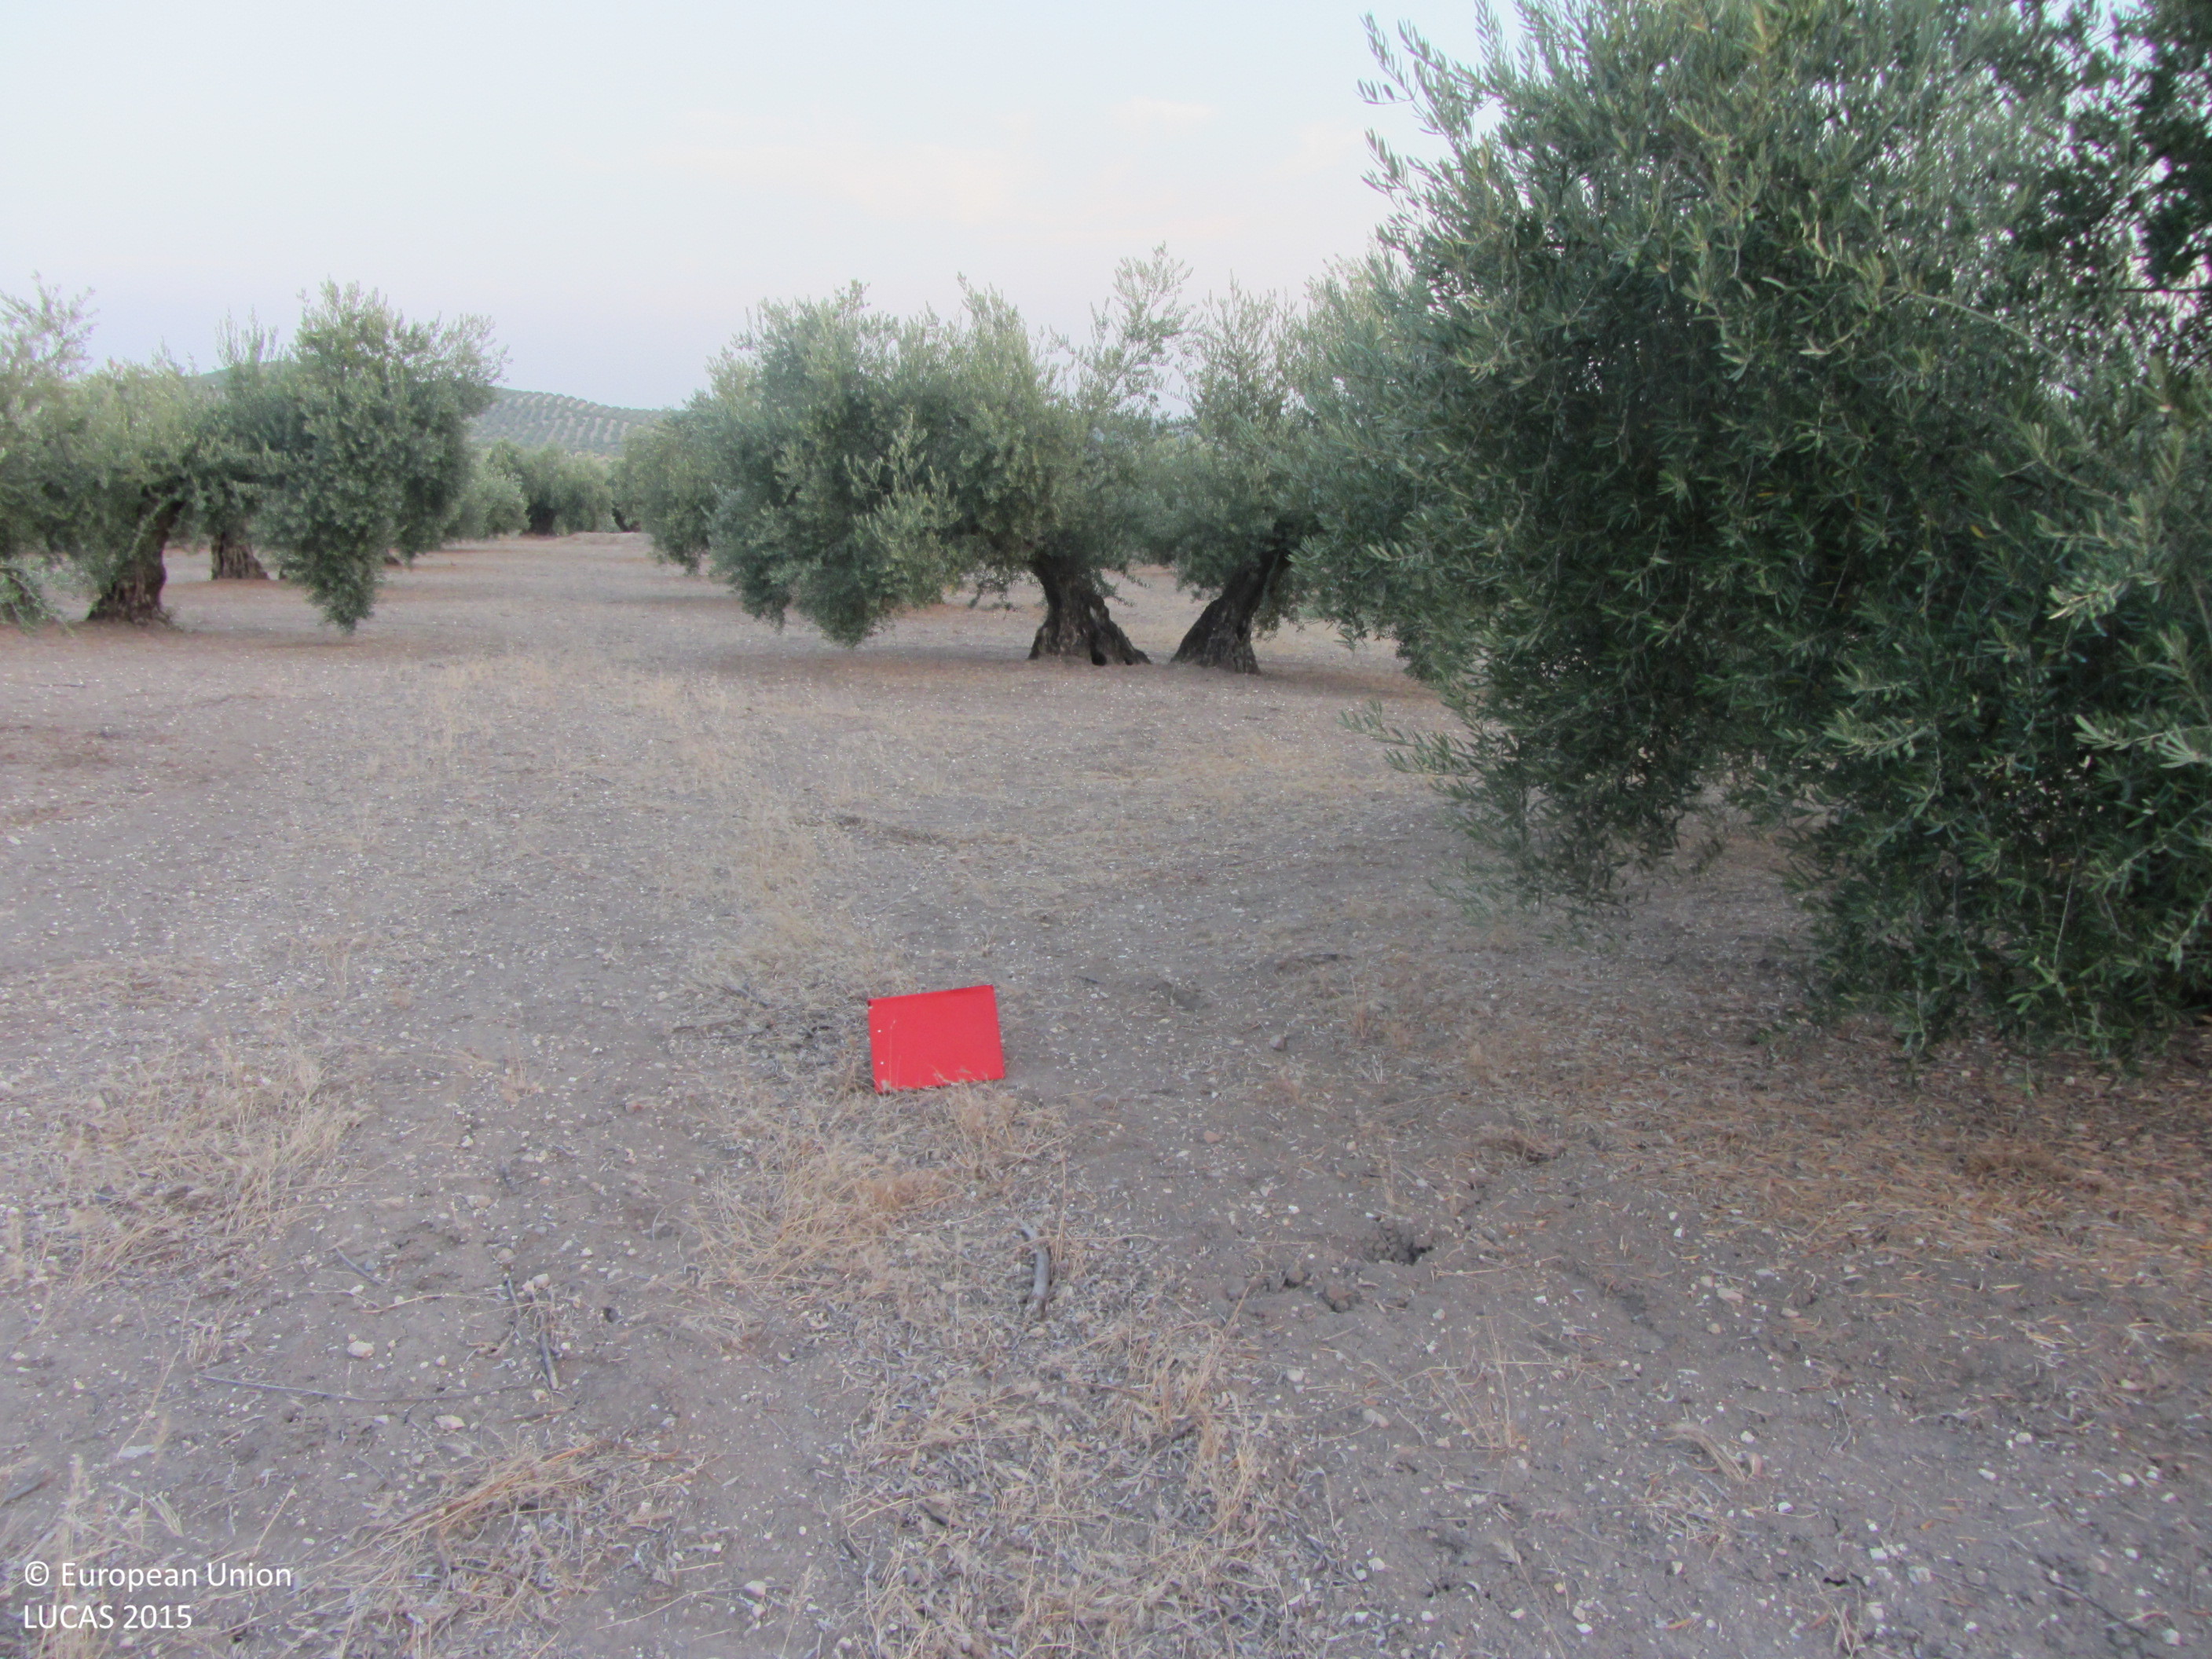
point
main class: Cropland
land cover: Olive groves
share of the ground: 25 - 50 %
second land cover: Other bare soil
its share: > 75 %
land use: Agriculture (excluding fallow land and kitchen gardens)
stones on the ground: < 10 %
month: July
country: ES
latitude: 37.8374
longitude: -4.1755
